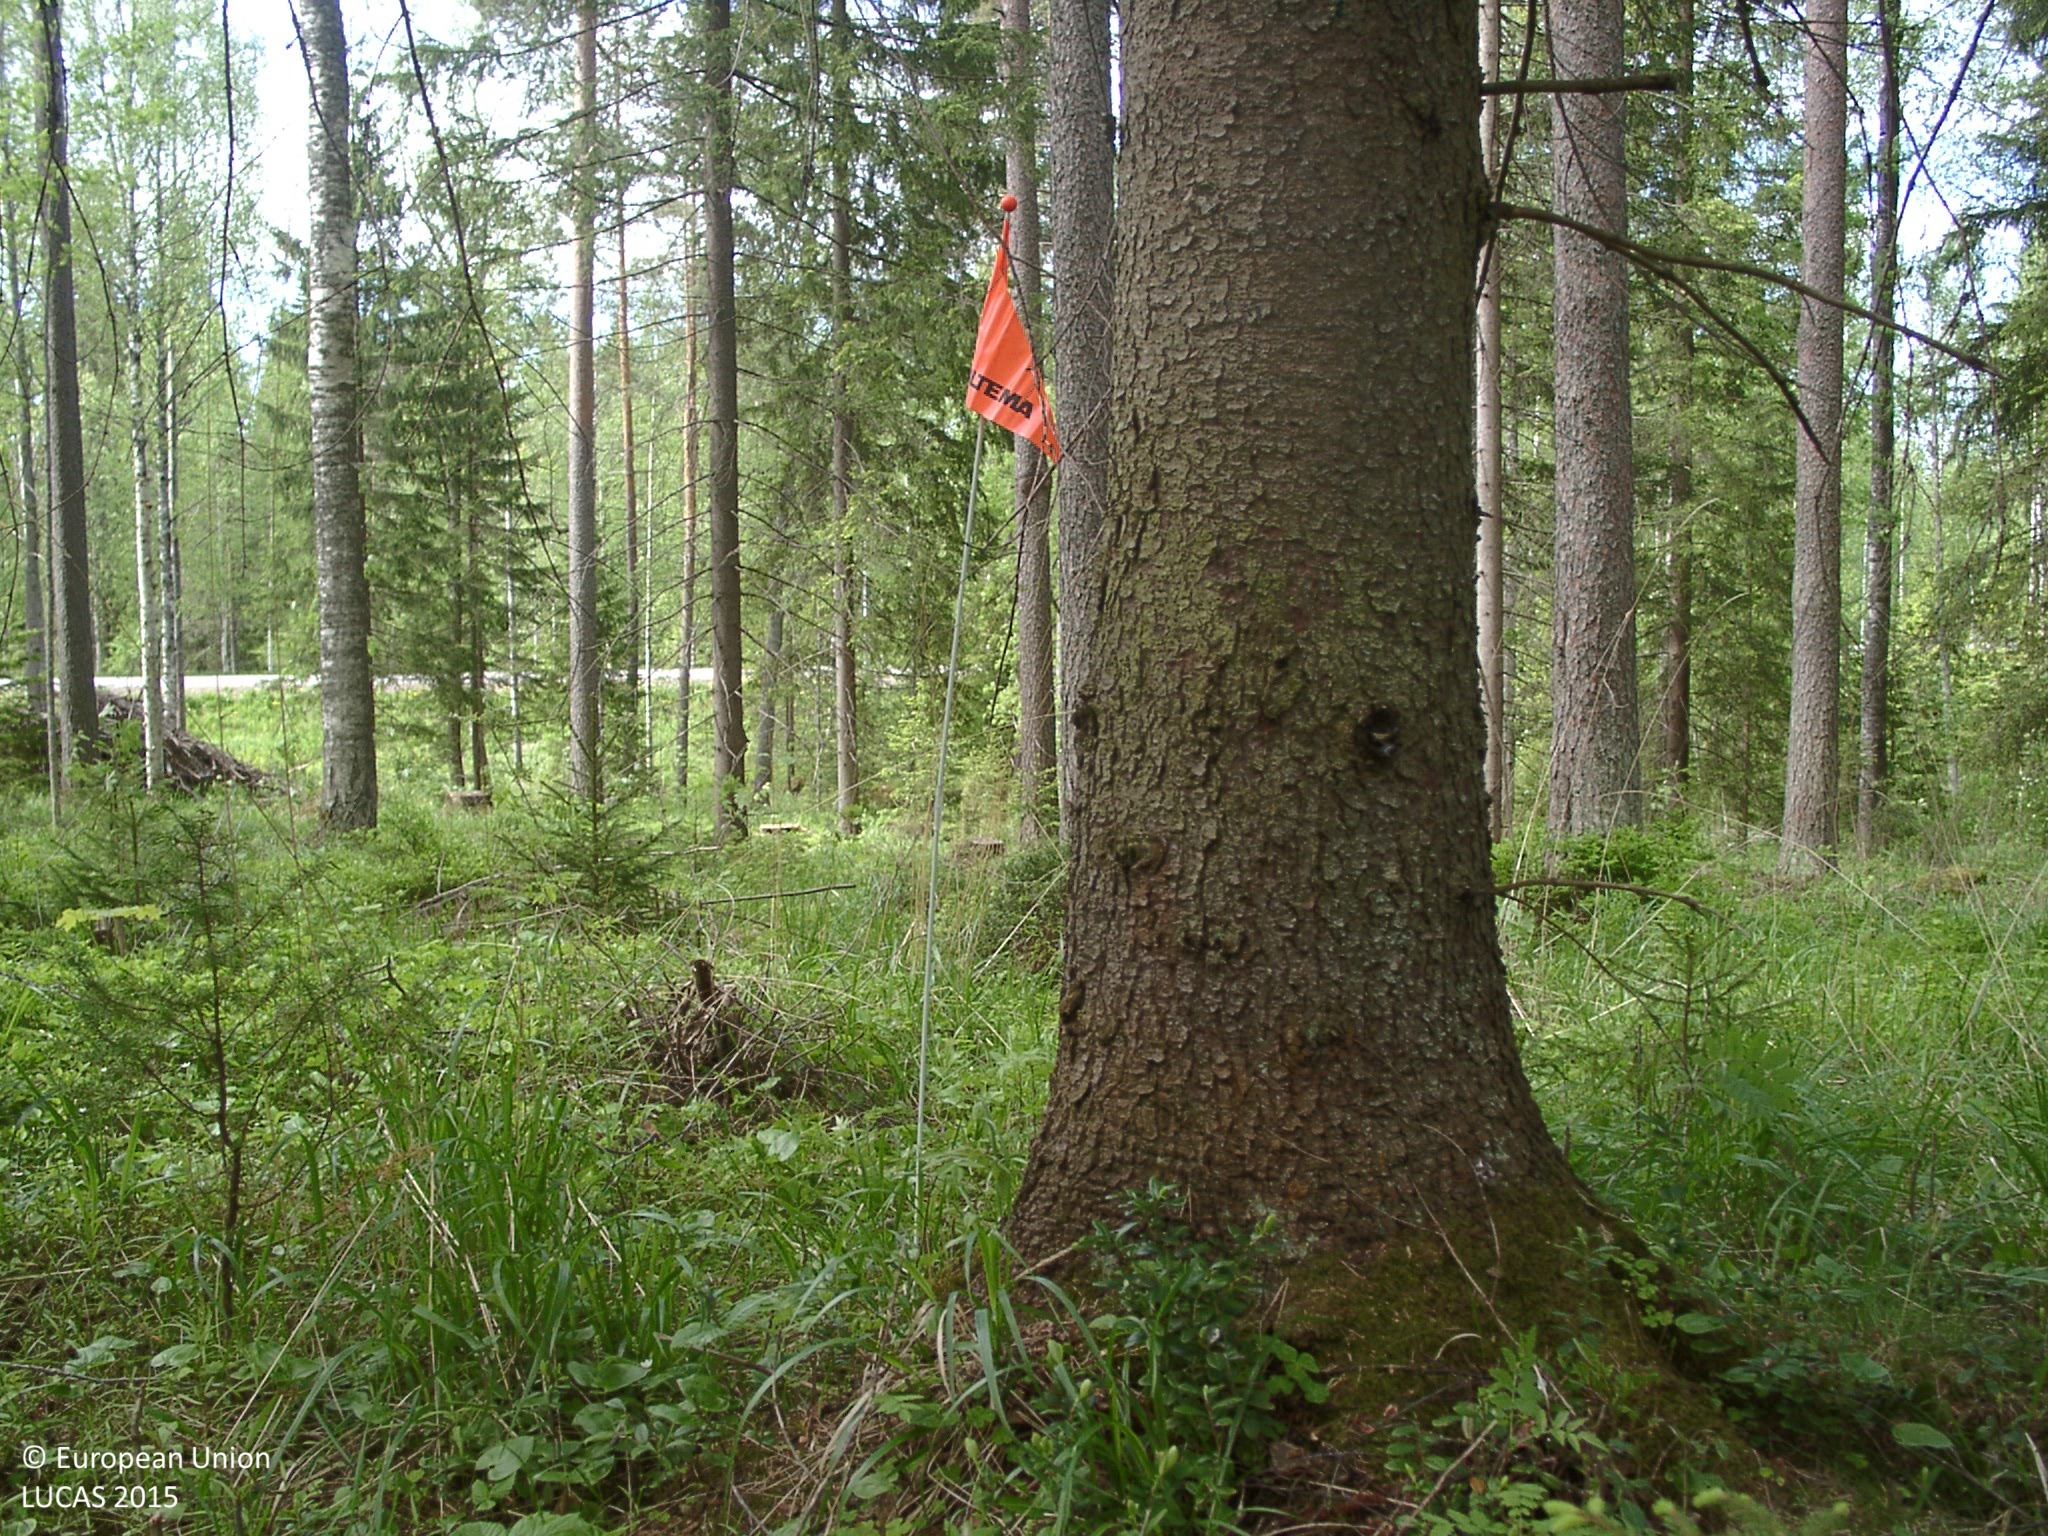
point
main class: Woodland
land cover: Other mixed woodland
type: boreal forest
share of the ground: 50 - 75 %
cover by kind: coniferous forest trees 40 %, broadleaved forest trees 20 %, shrubs 20 %, herbaceous plants 20 %
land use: Amenities, museums, leisure
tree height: > 5 m
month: June
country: FI
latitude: 62.2433
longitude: 25.6900
